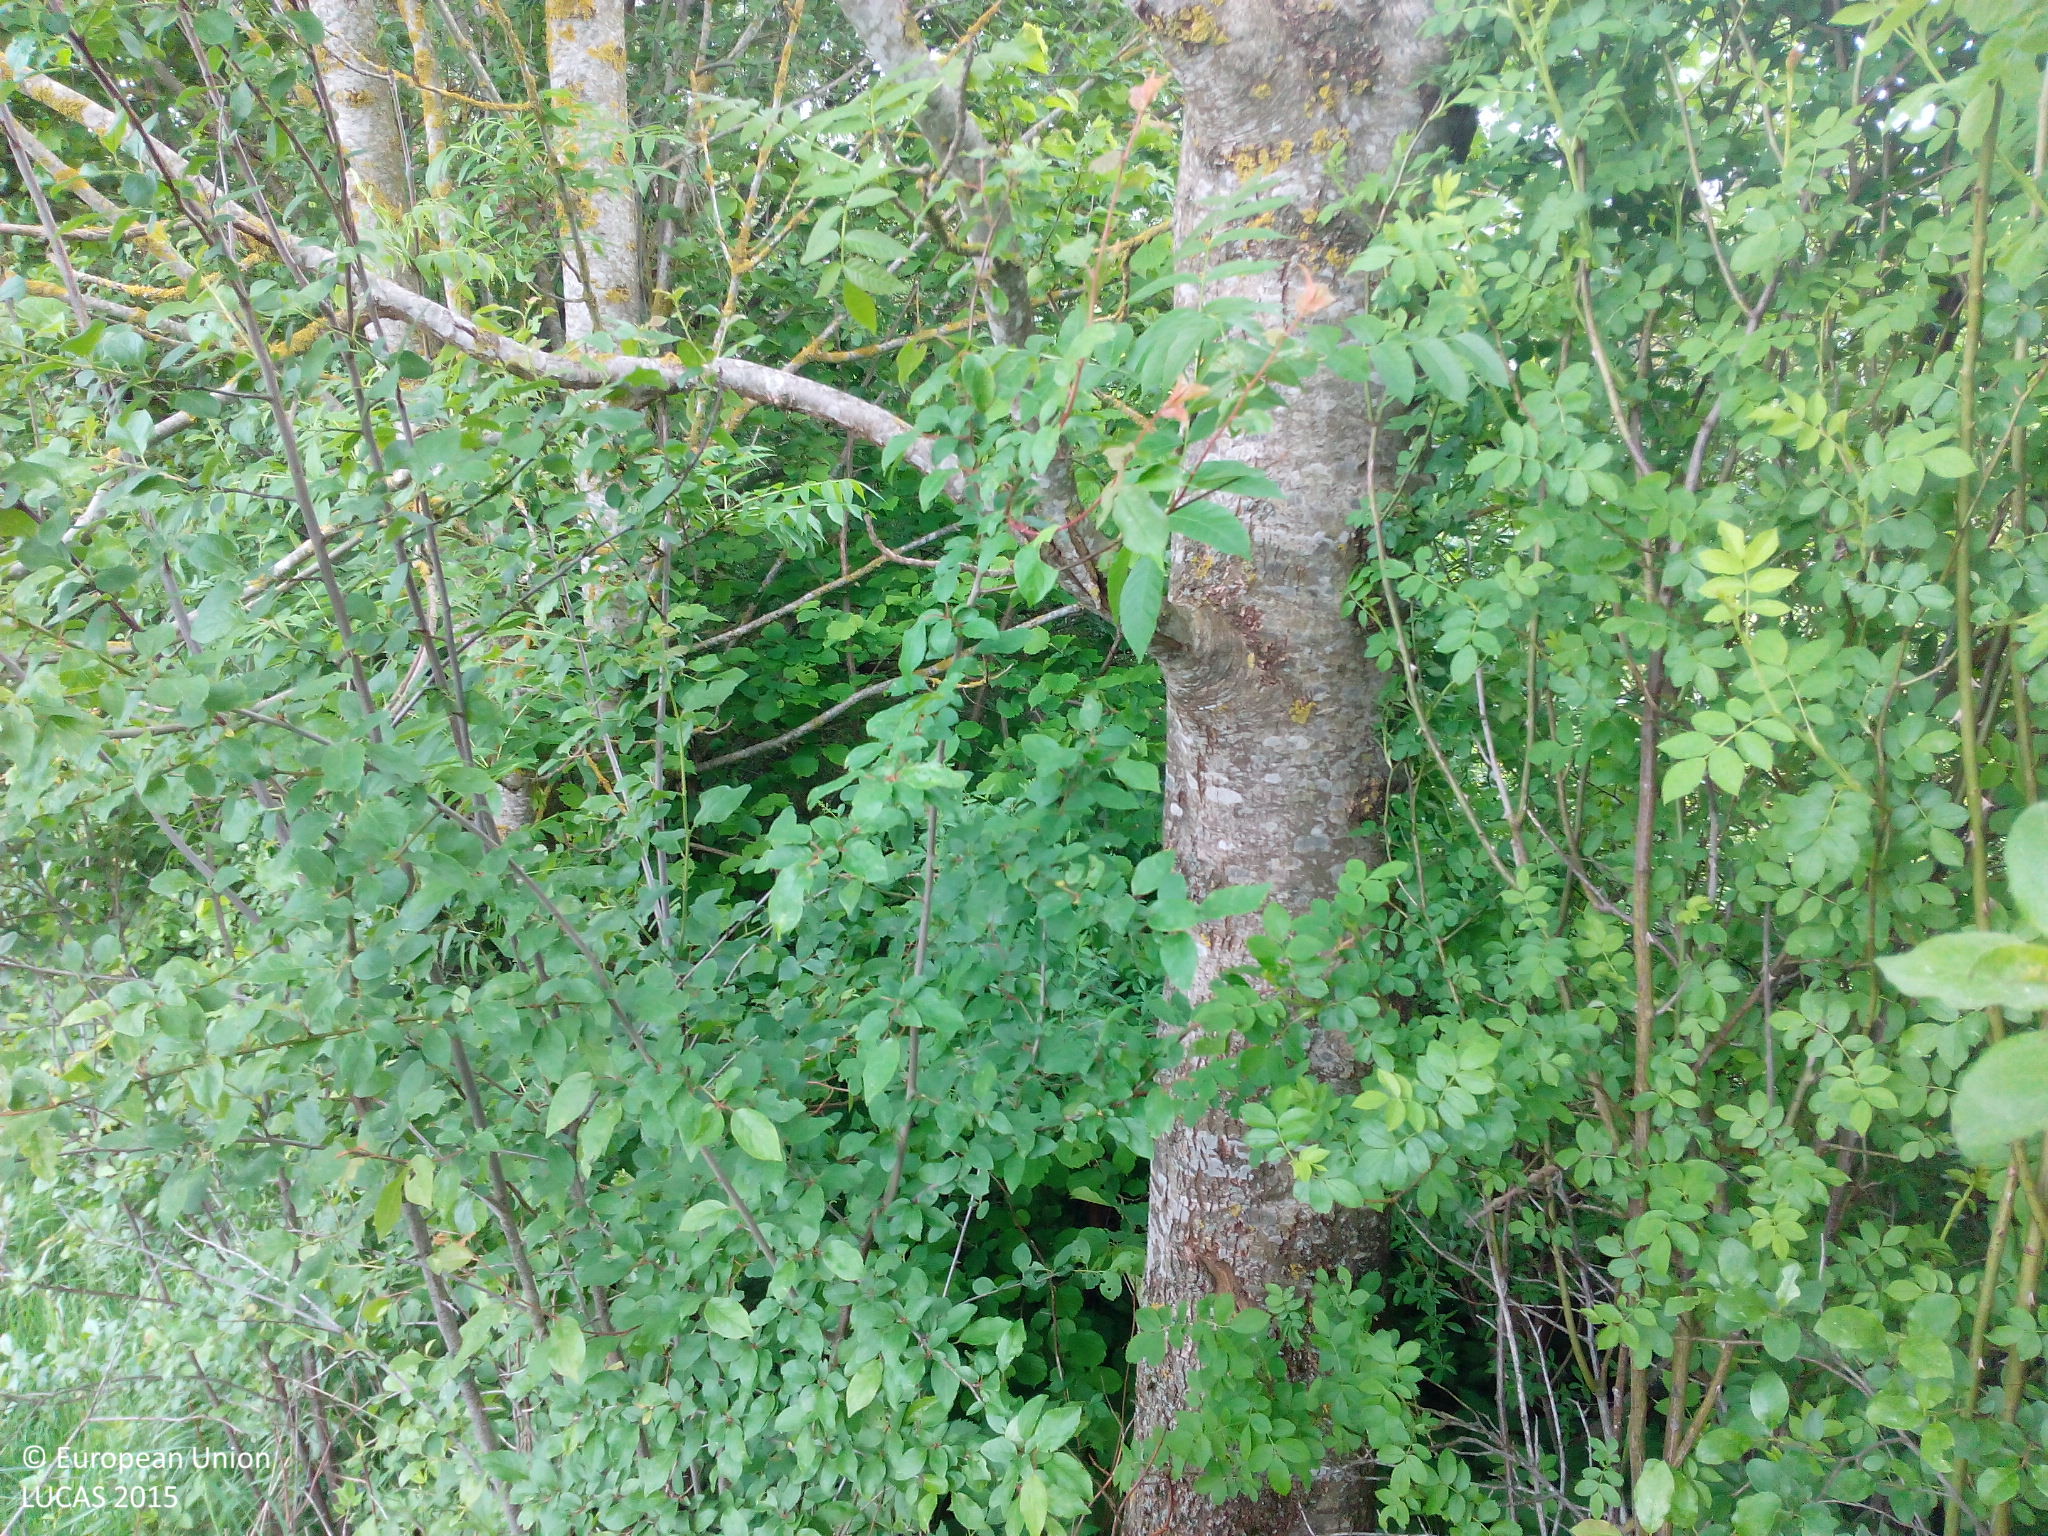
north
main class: Grassland
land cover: Grassland with sparse tree/shrub cover
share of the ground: > 75 %
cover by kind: herbaceous plants 95 %, broadleaved forest trees 5 %
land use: Residential
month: May
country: DE
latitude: 48.1155
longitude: 9.9329
